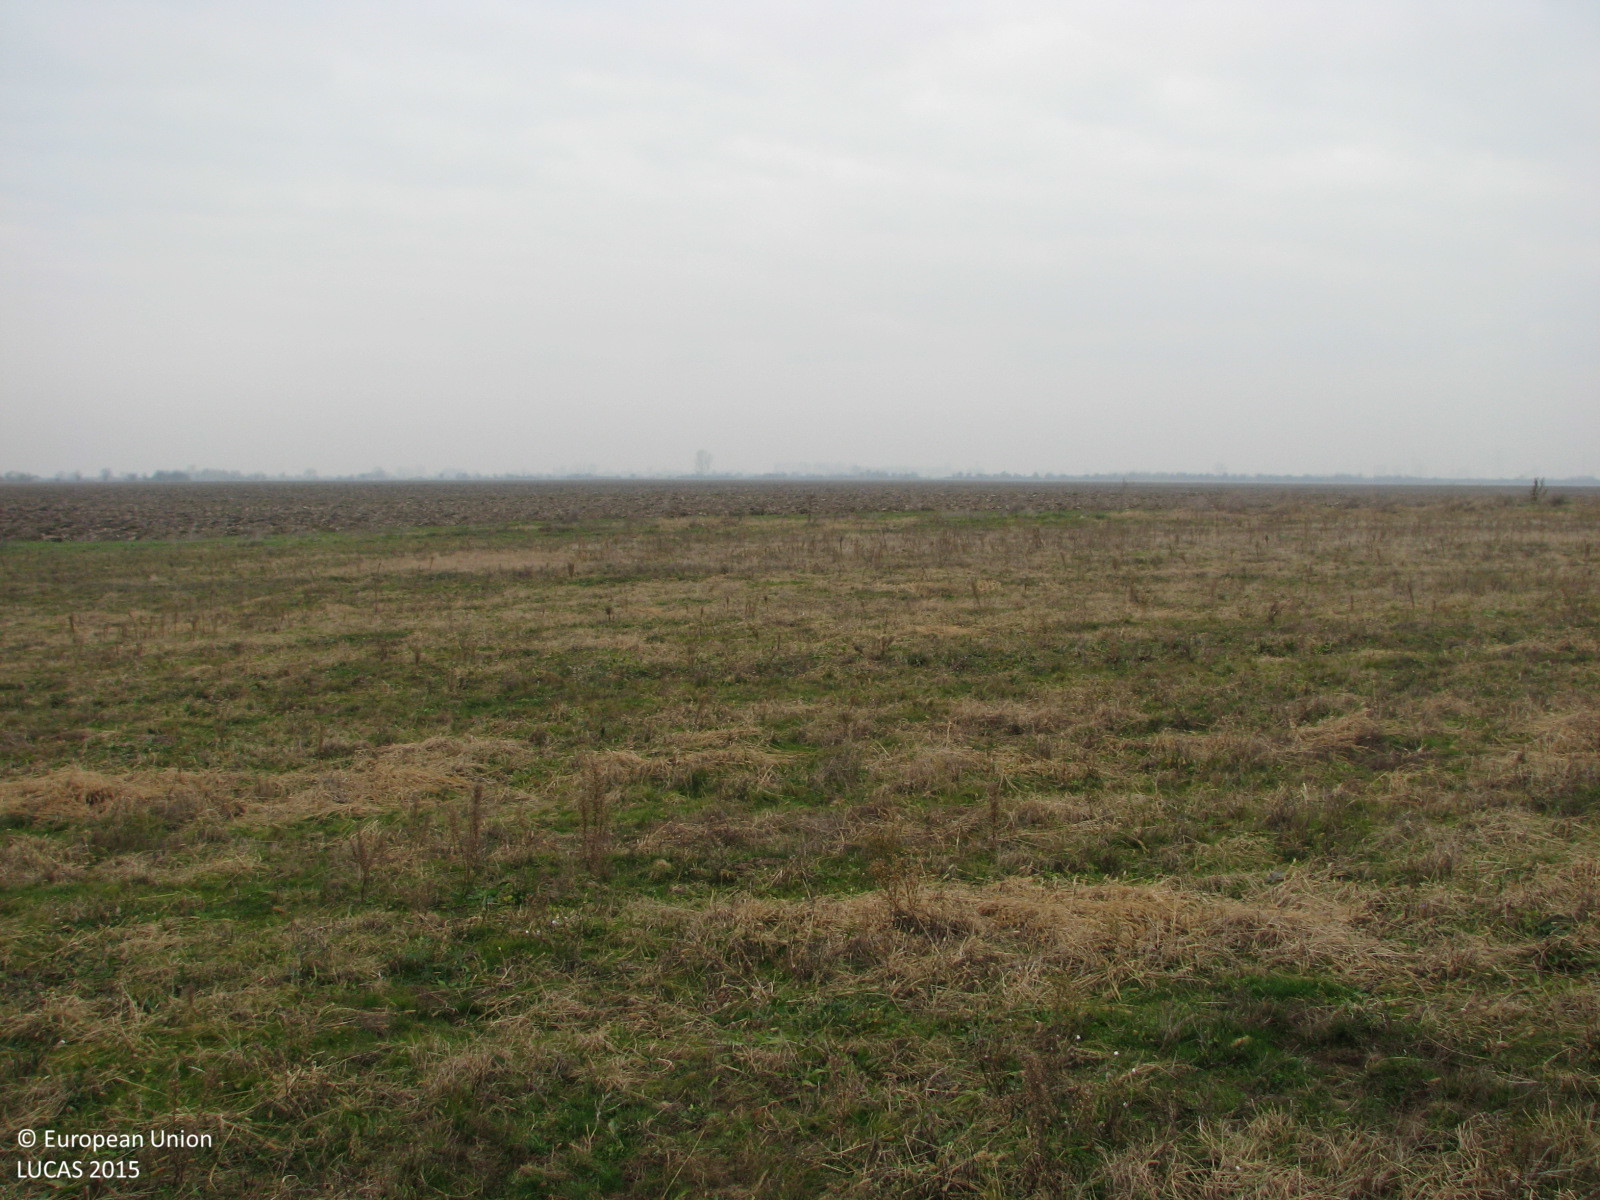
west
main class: Grassland
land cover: Spontaneously vegetated surfaces
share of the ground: > 75 %
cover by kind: herbaceous plants 100 %
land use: Agriculture (excluding fallow land and kitchen gardens)
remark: Harvested field
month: December
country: BG
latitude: 42.3086
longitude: 24.8188
